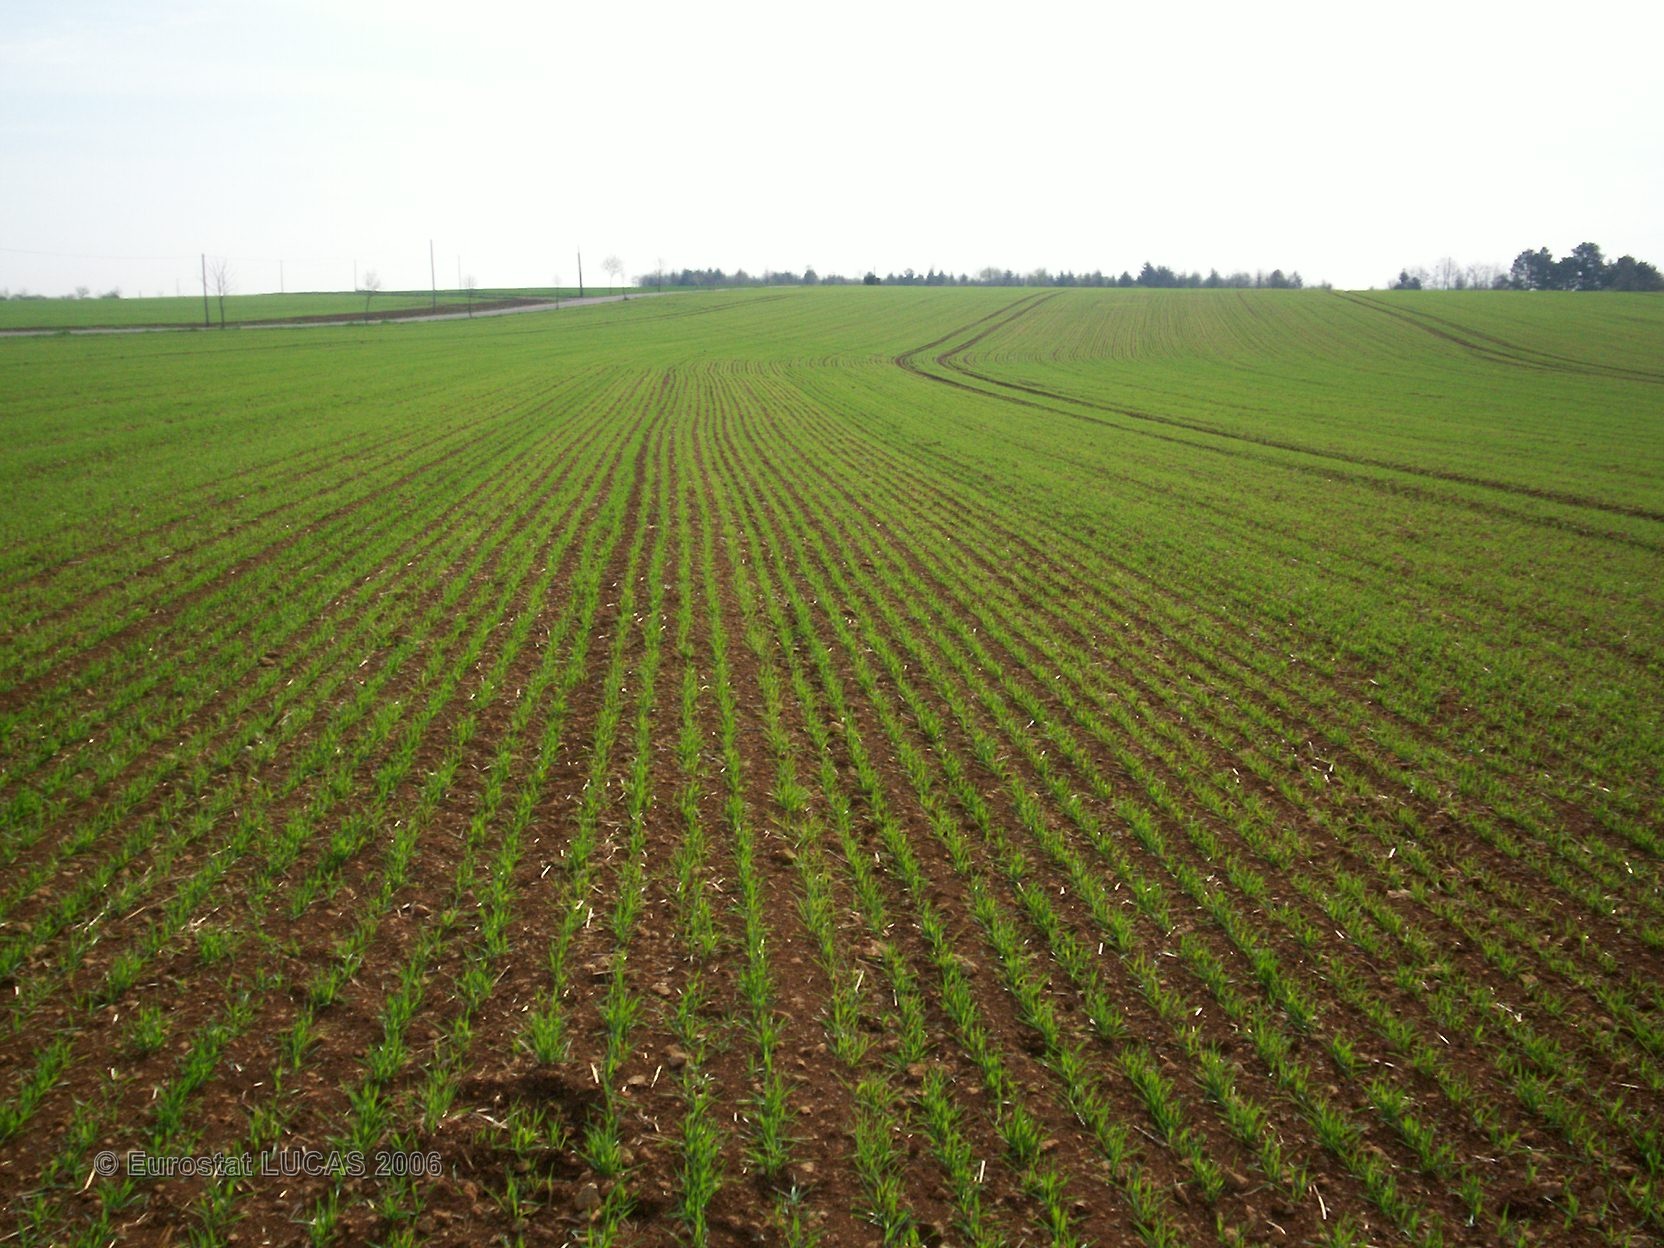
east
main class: Cropland
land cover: Barley
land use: Agriculture (excluding fallow land and kitchen gardens)
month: April
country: FR
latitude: 48.9037
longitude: 5.8931
